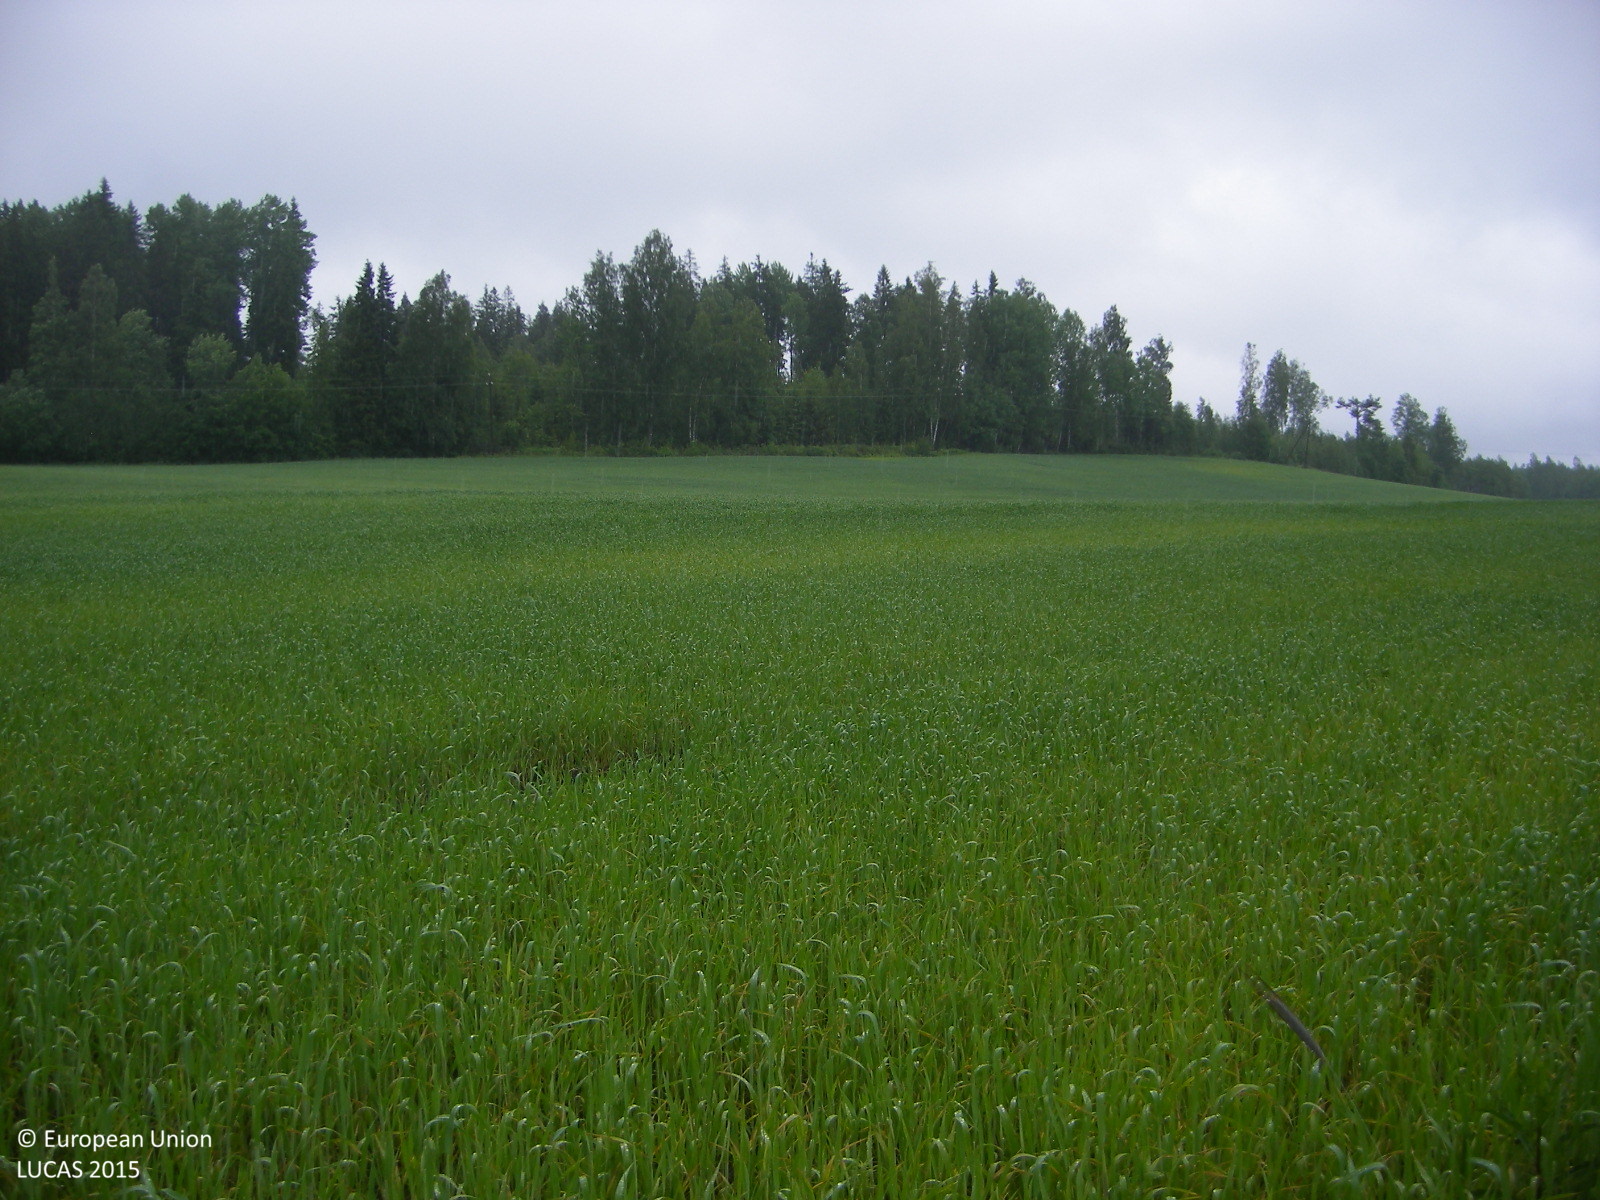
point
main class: Cropland
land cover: Common wheat
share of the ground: > 75 %
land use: Agriculture (excluding fallow land and kitchen gardens)
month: June
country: FI
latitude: 60.1287
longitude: 24.0865
